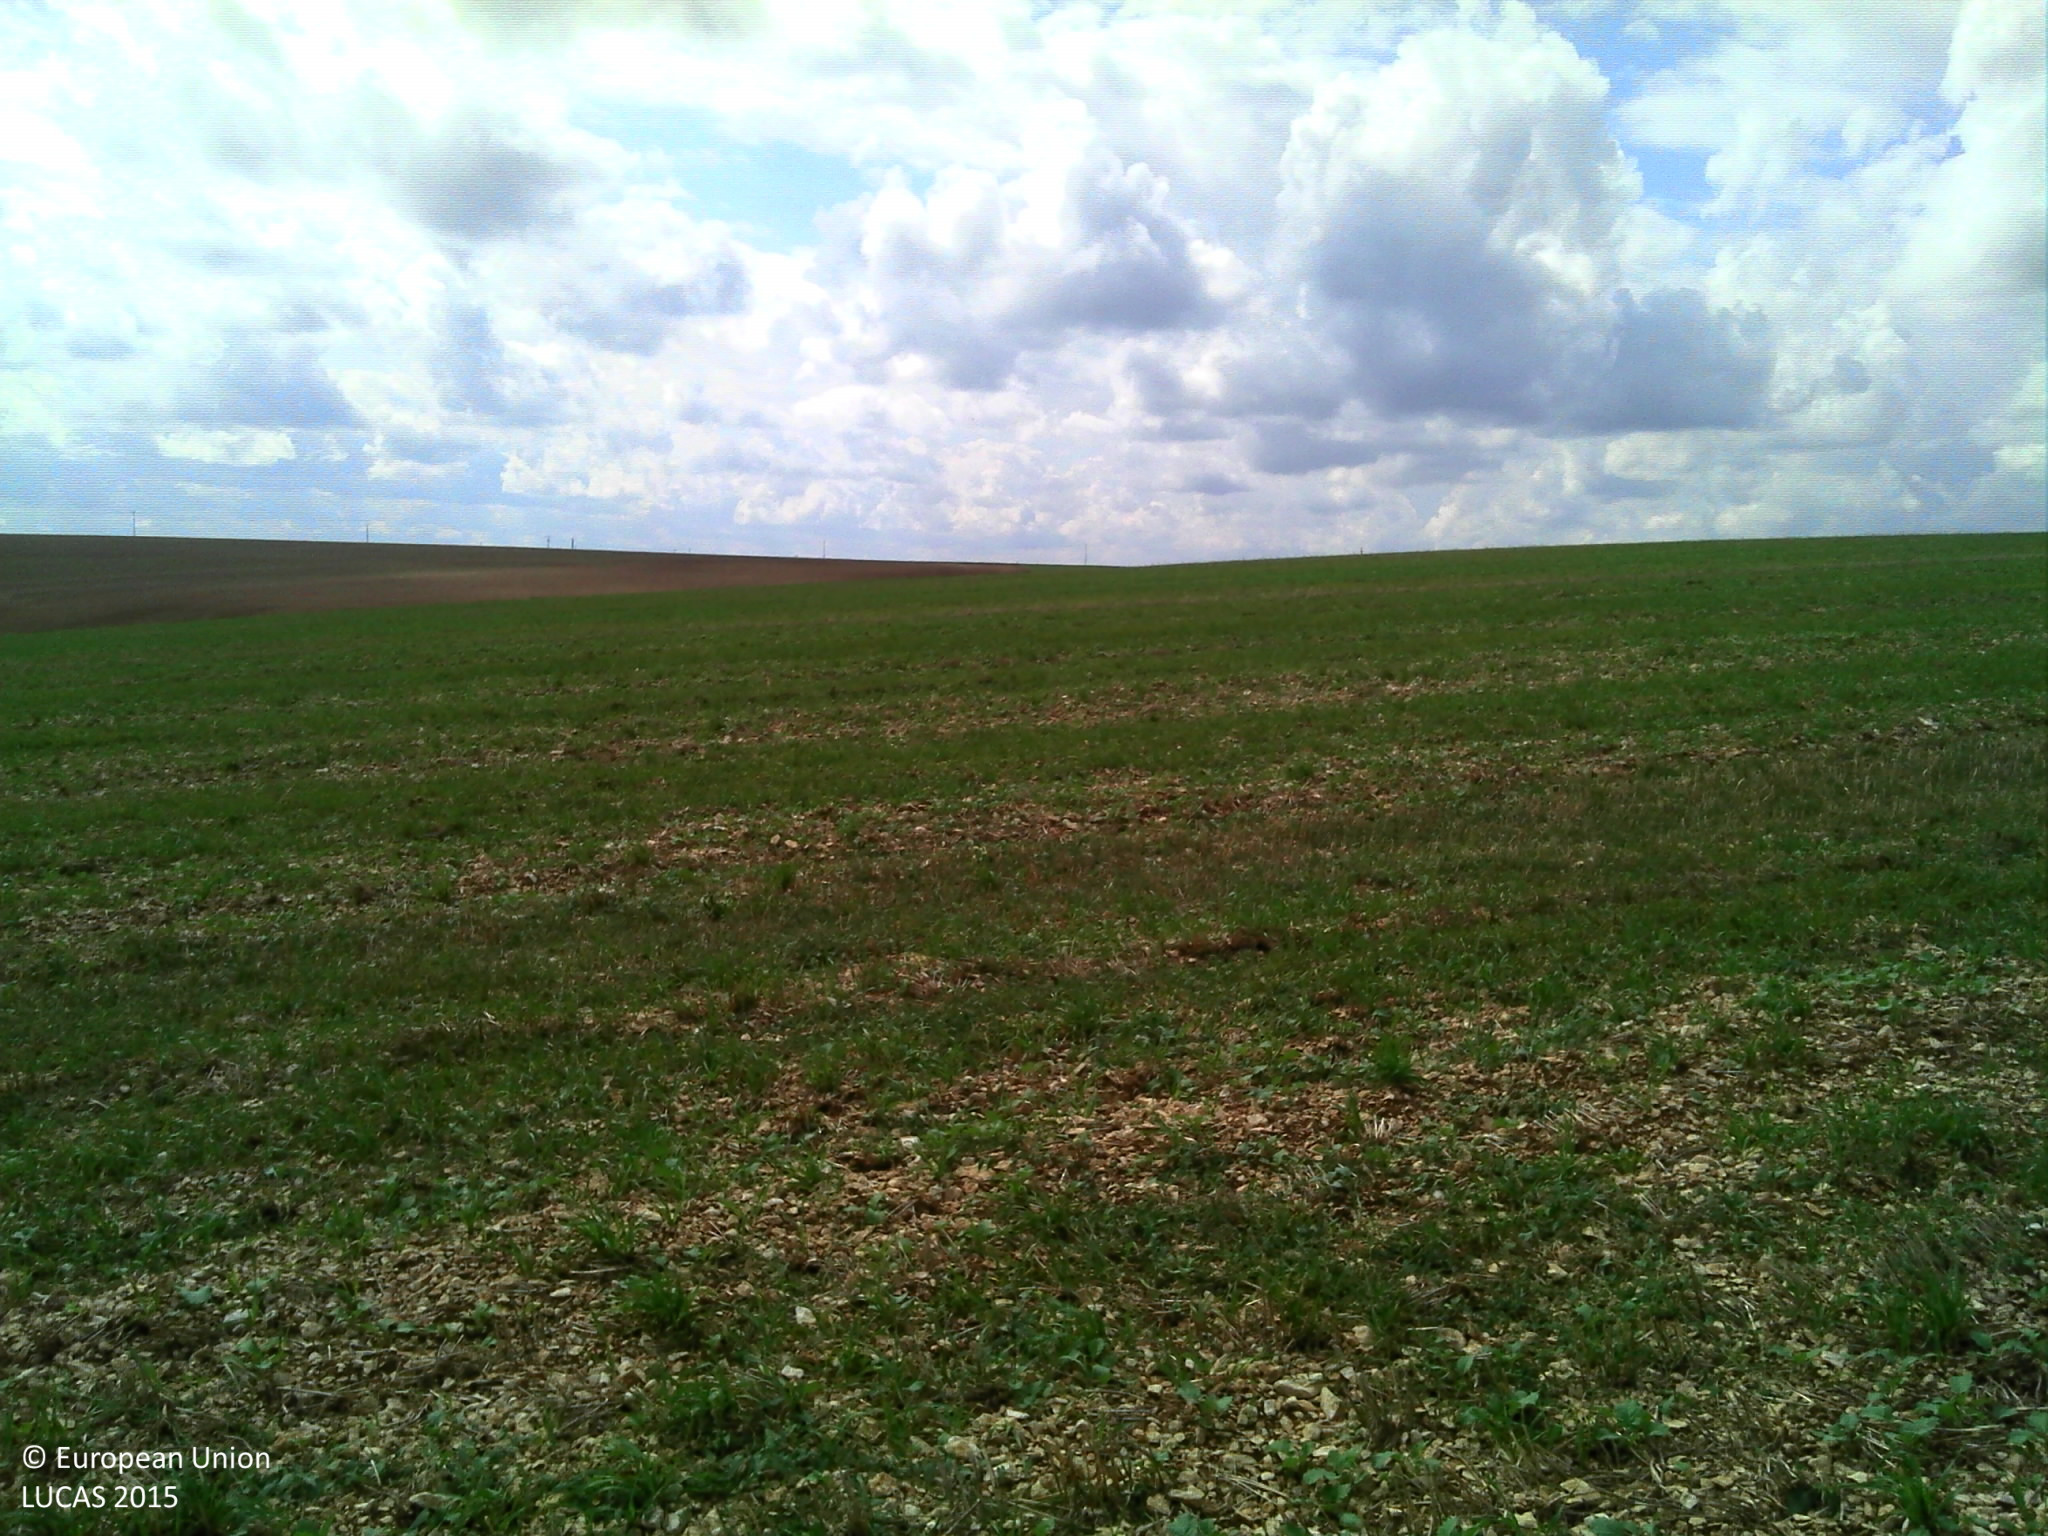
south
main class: Cropland
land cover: Barley
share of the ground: 10 - 25 %
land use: Agriculture (excluding fallow land and kitchen gardens)
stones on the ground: > 50 %
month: September
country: FR
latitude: 47.6368
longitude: 4.9020
